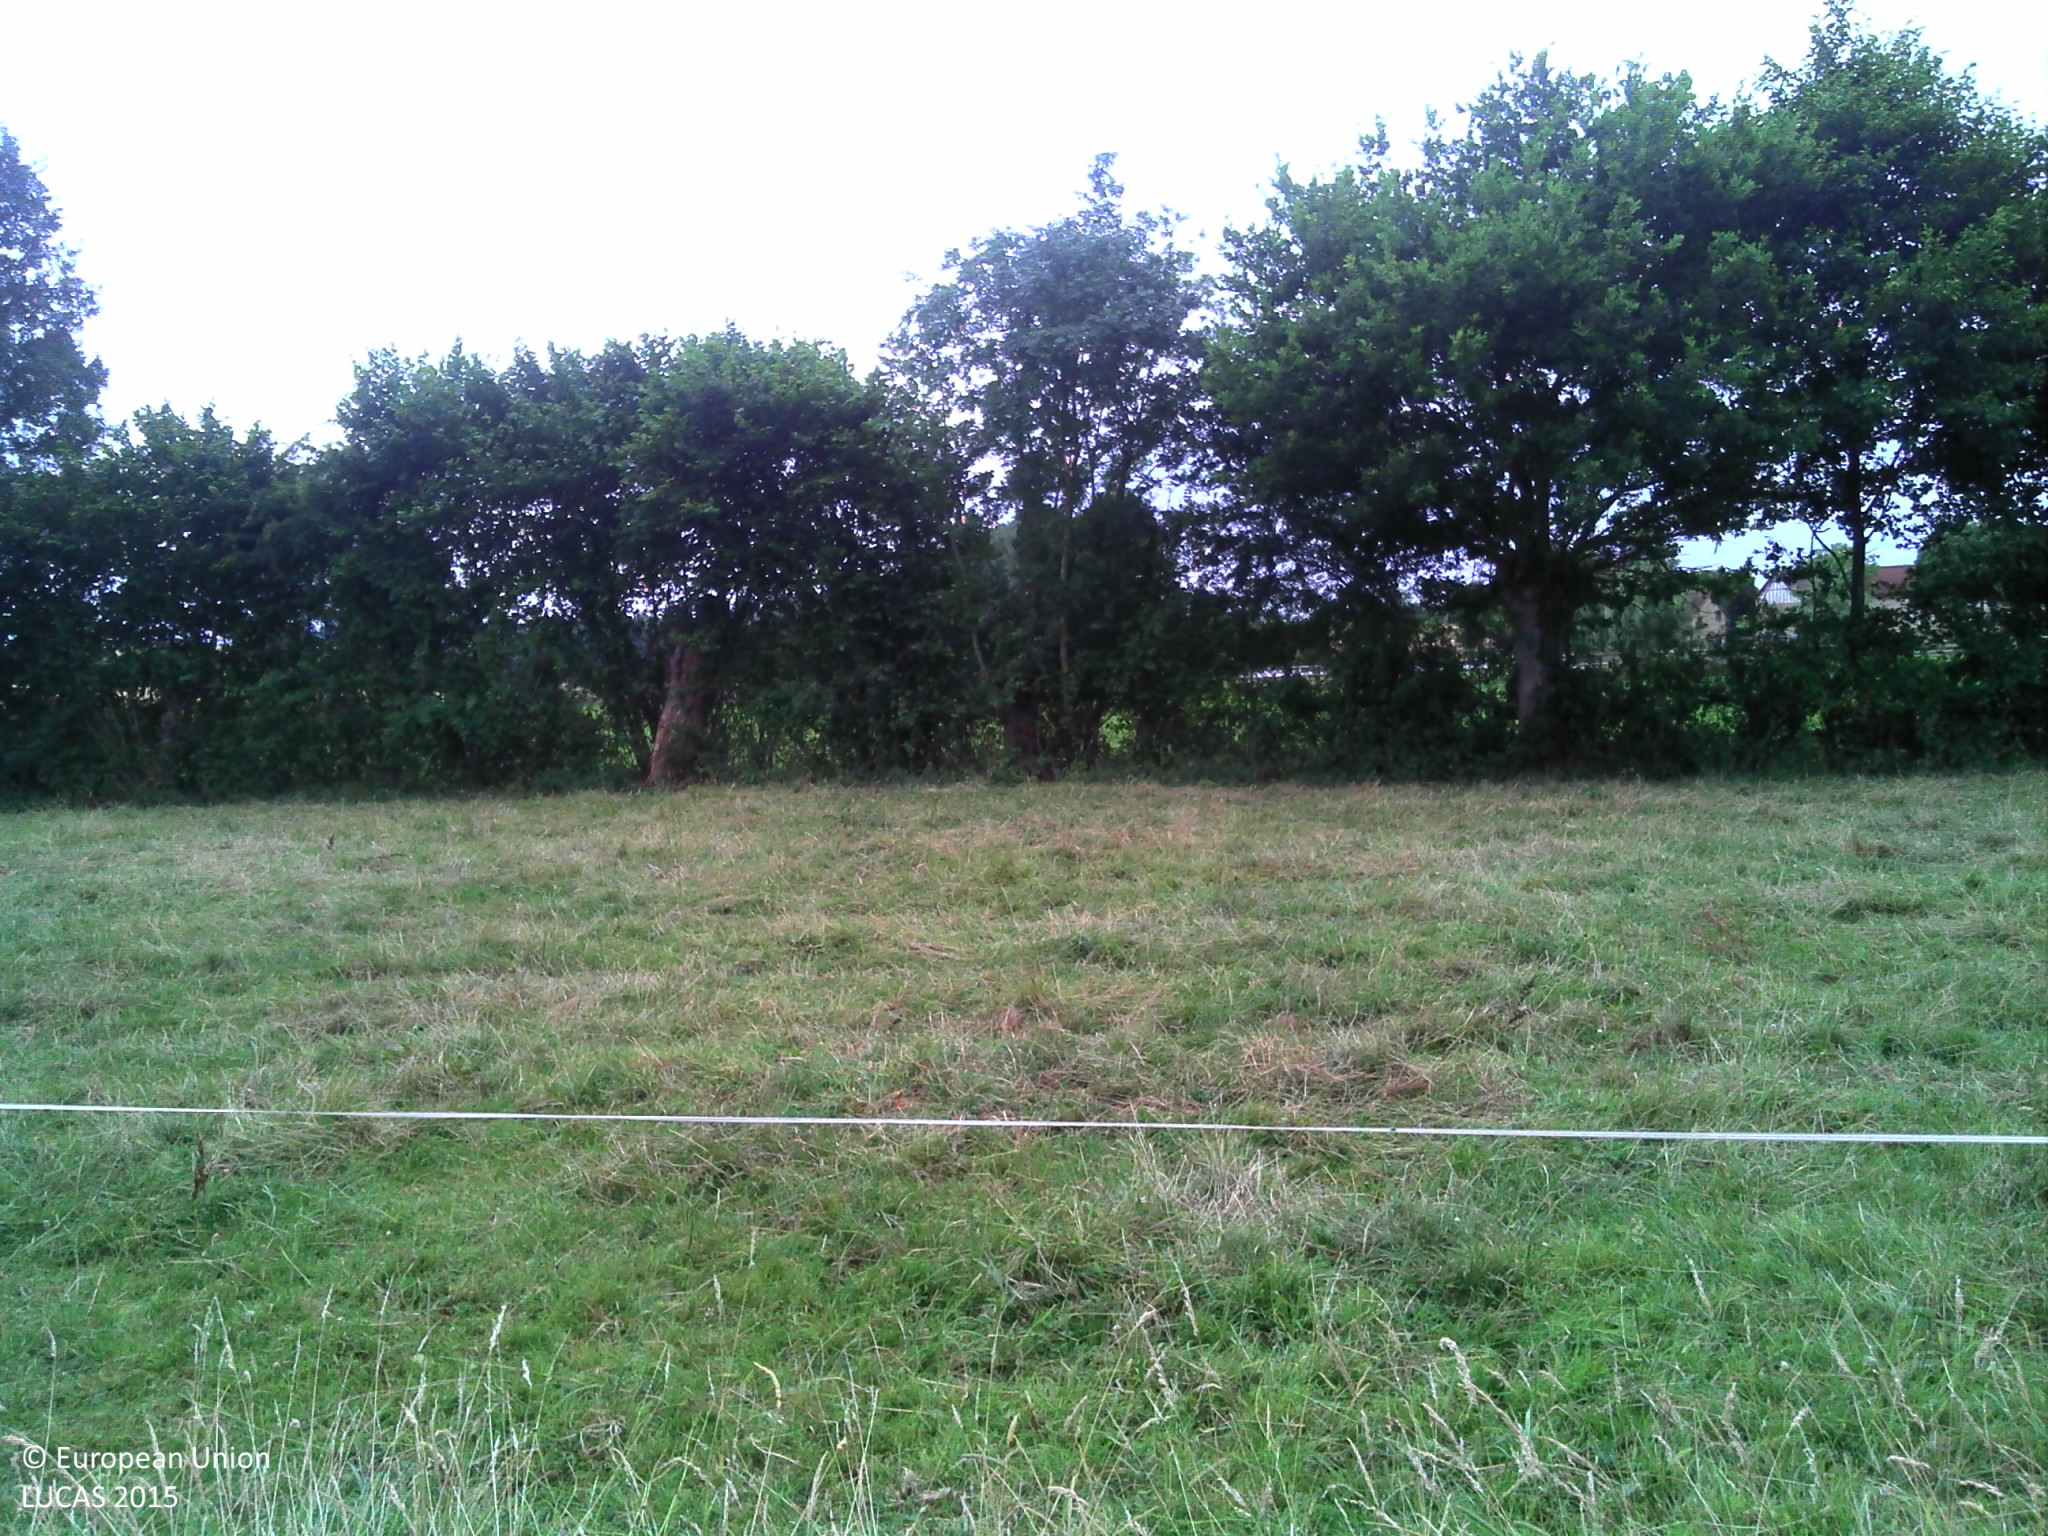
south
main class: Grassland
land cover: Grassland without tree/shrub cover
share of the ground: > 75 %
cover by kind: herbaceous plants 100 %
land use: Agriculture (excluding fallow land and kitchen gardens)
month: July
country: FR
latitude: 48.5711
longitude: 0.4743
